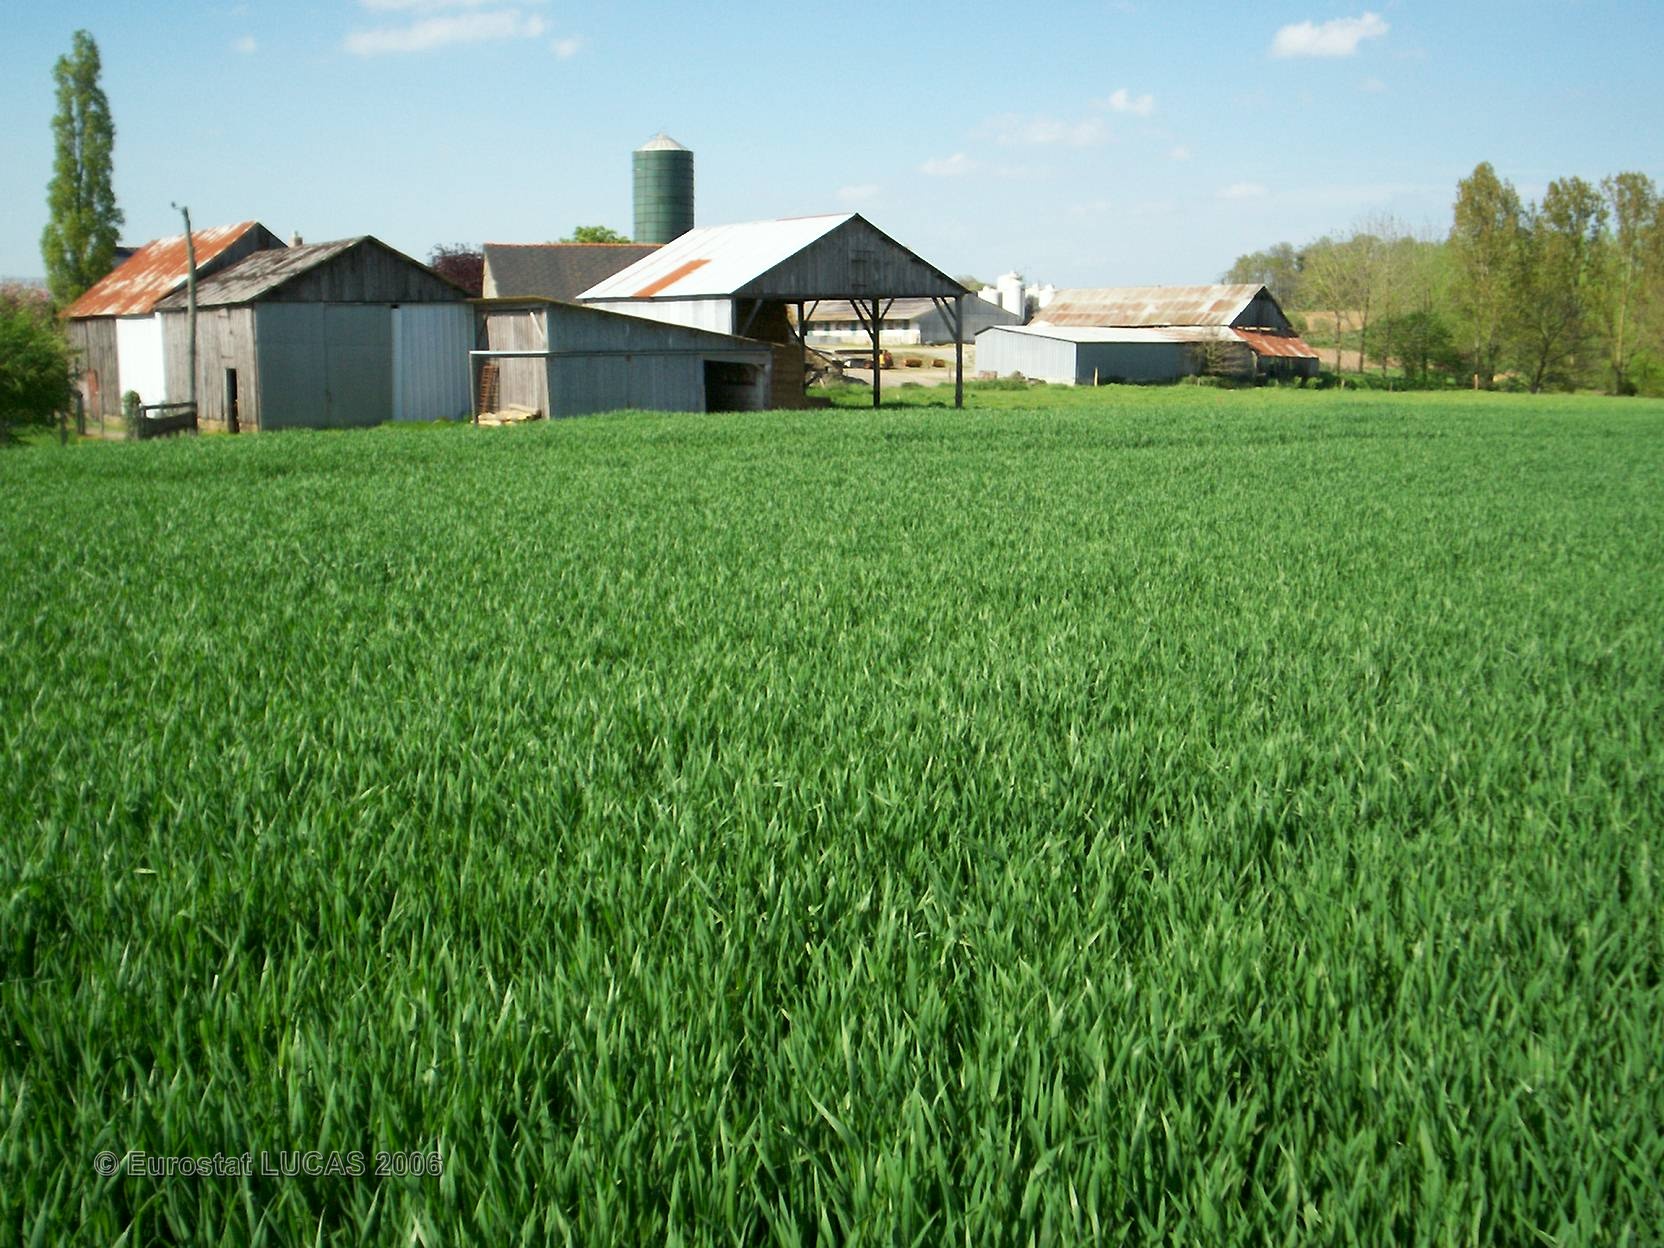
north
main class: Cropland
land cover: Common wheat
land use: Agriculture (excluding fallow land and kitchen gardens)
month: May
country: FR
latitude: 48.1457
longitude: -1.1565
